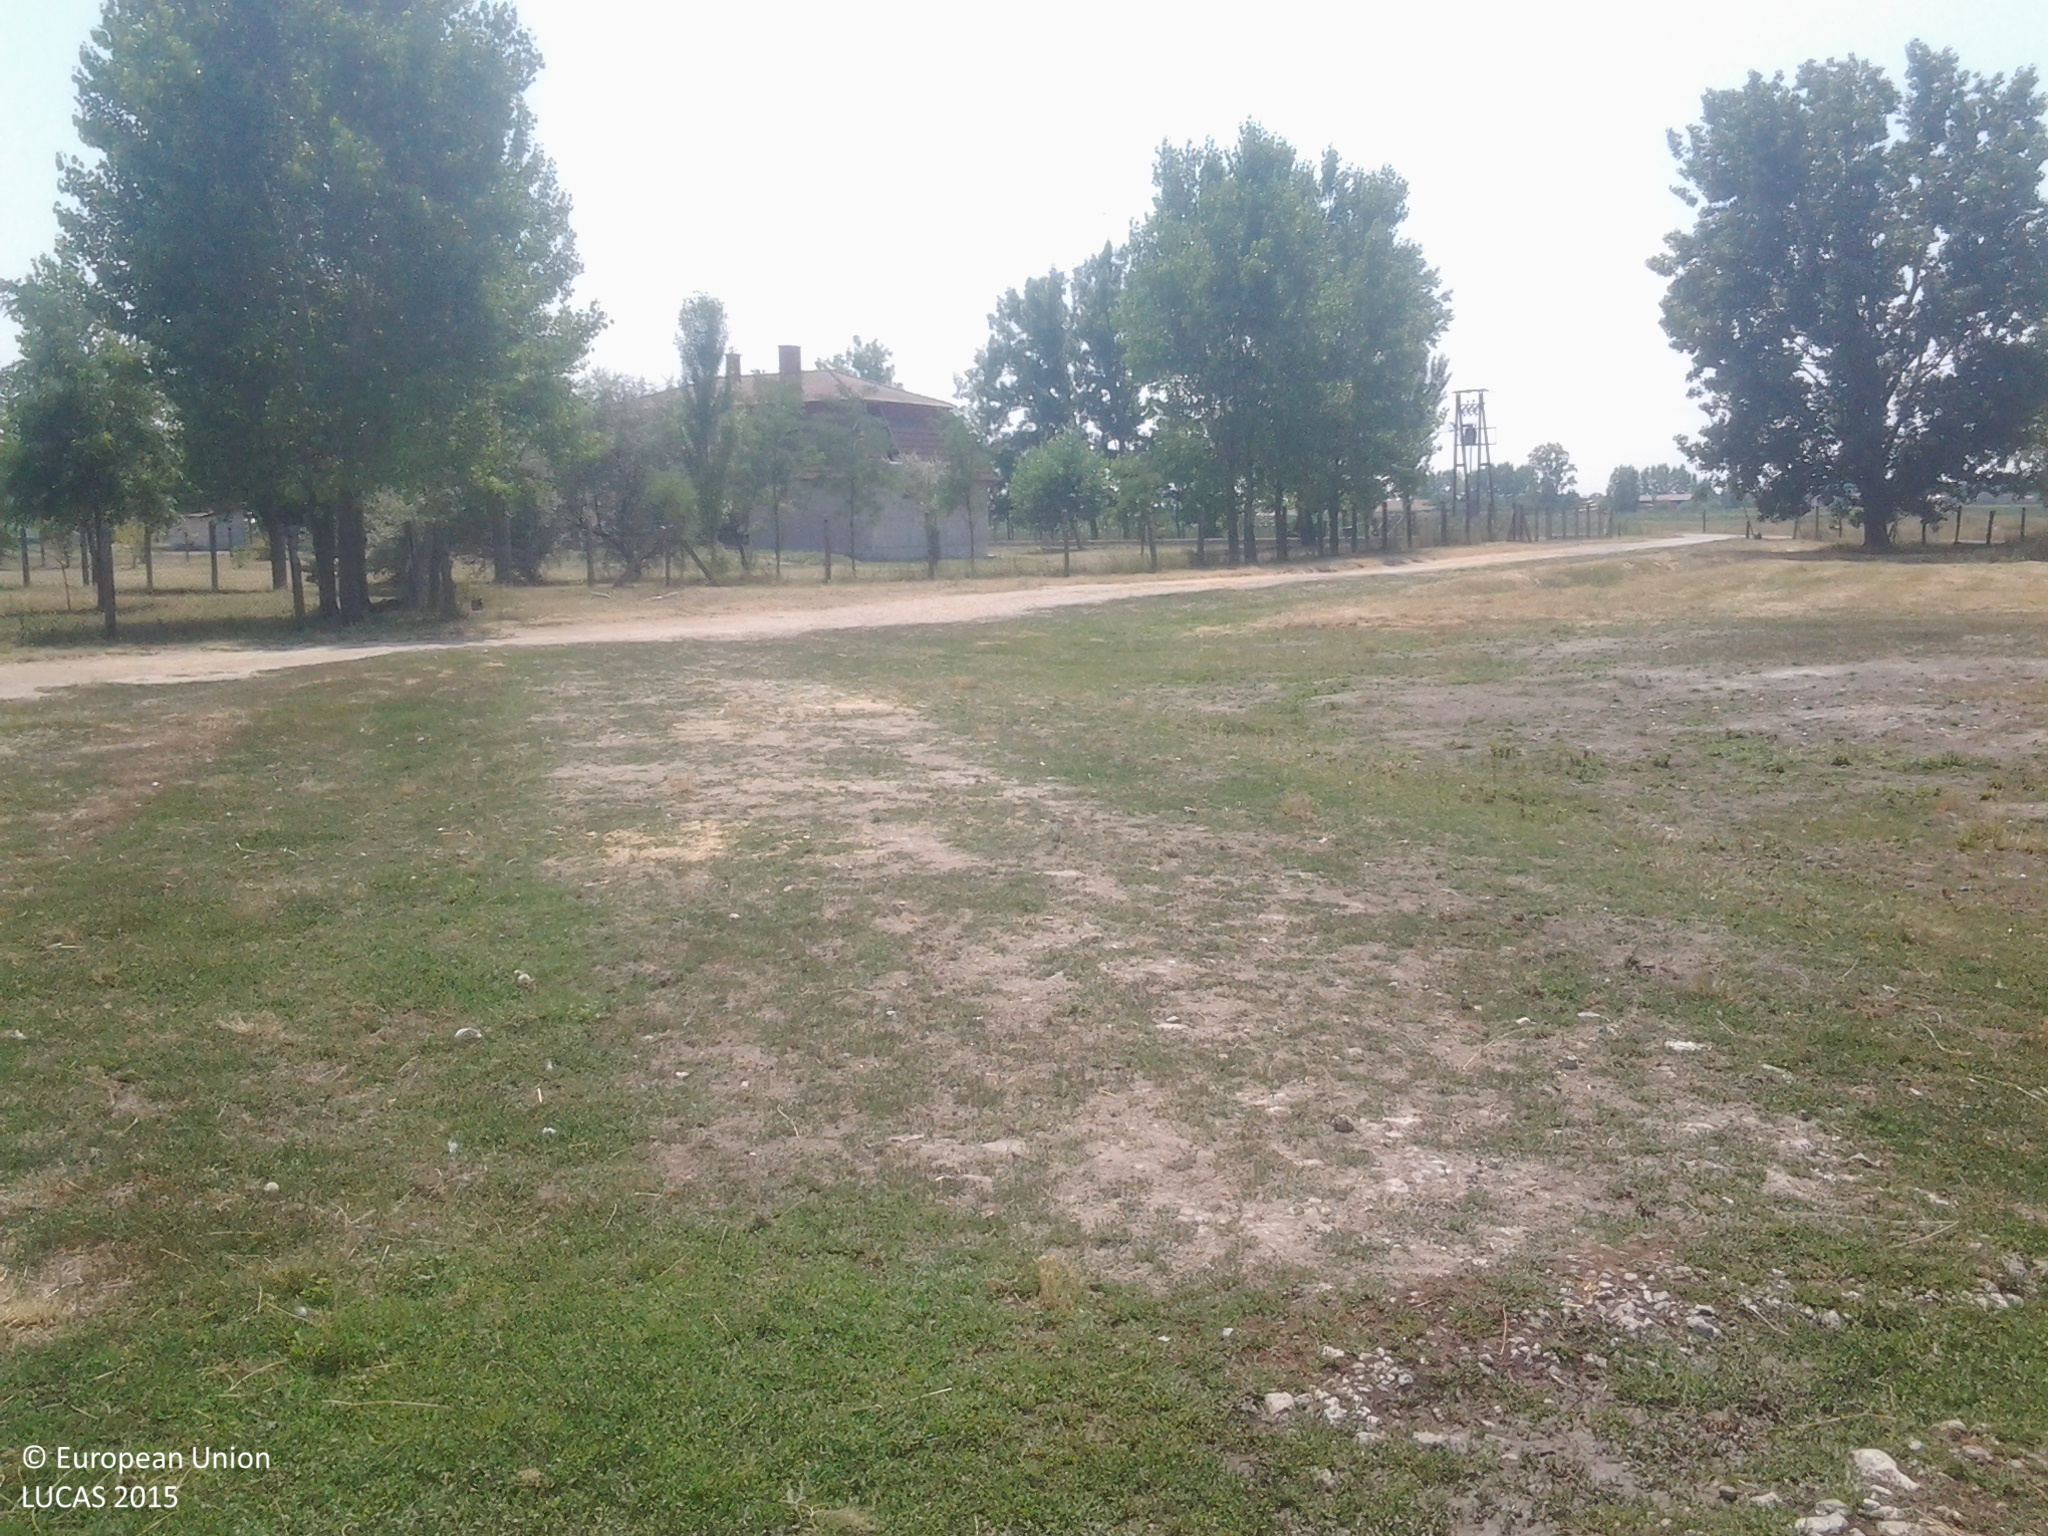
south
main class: Grassland
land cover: Grassland without tree/shrub cover
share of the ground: > 75 %
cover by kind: herbaceous plants 100 %
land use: Residential
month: July
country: HU
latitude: 47.0464
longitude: 19.1384
